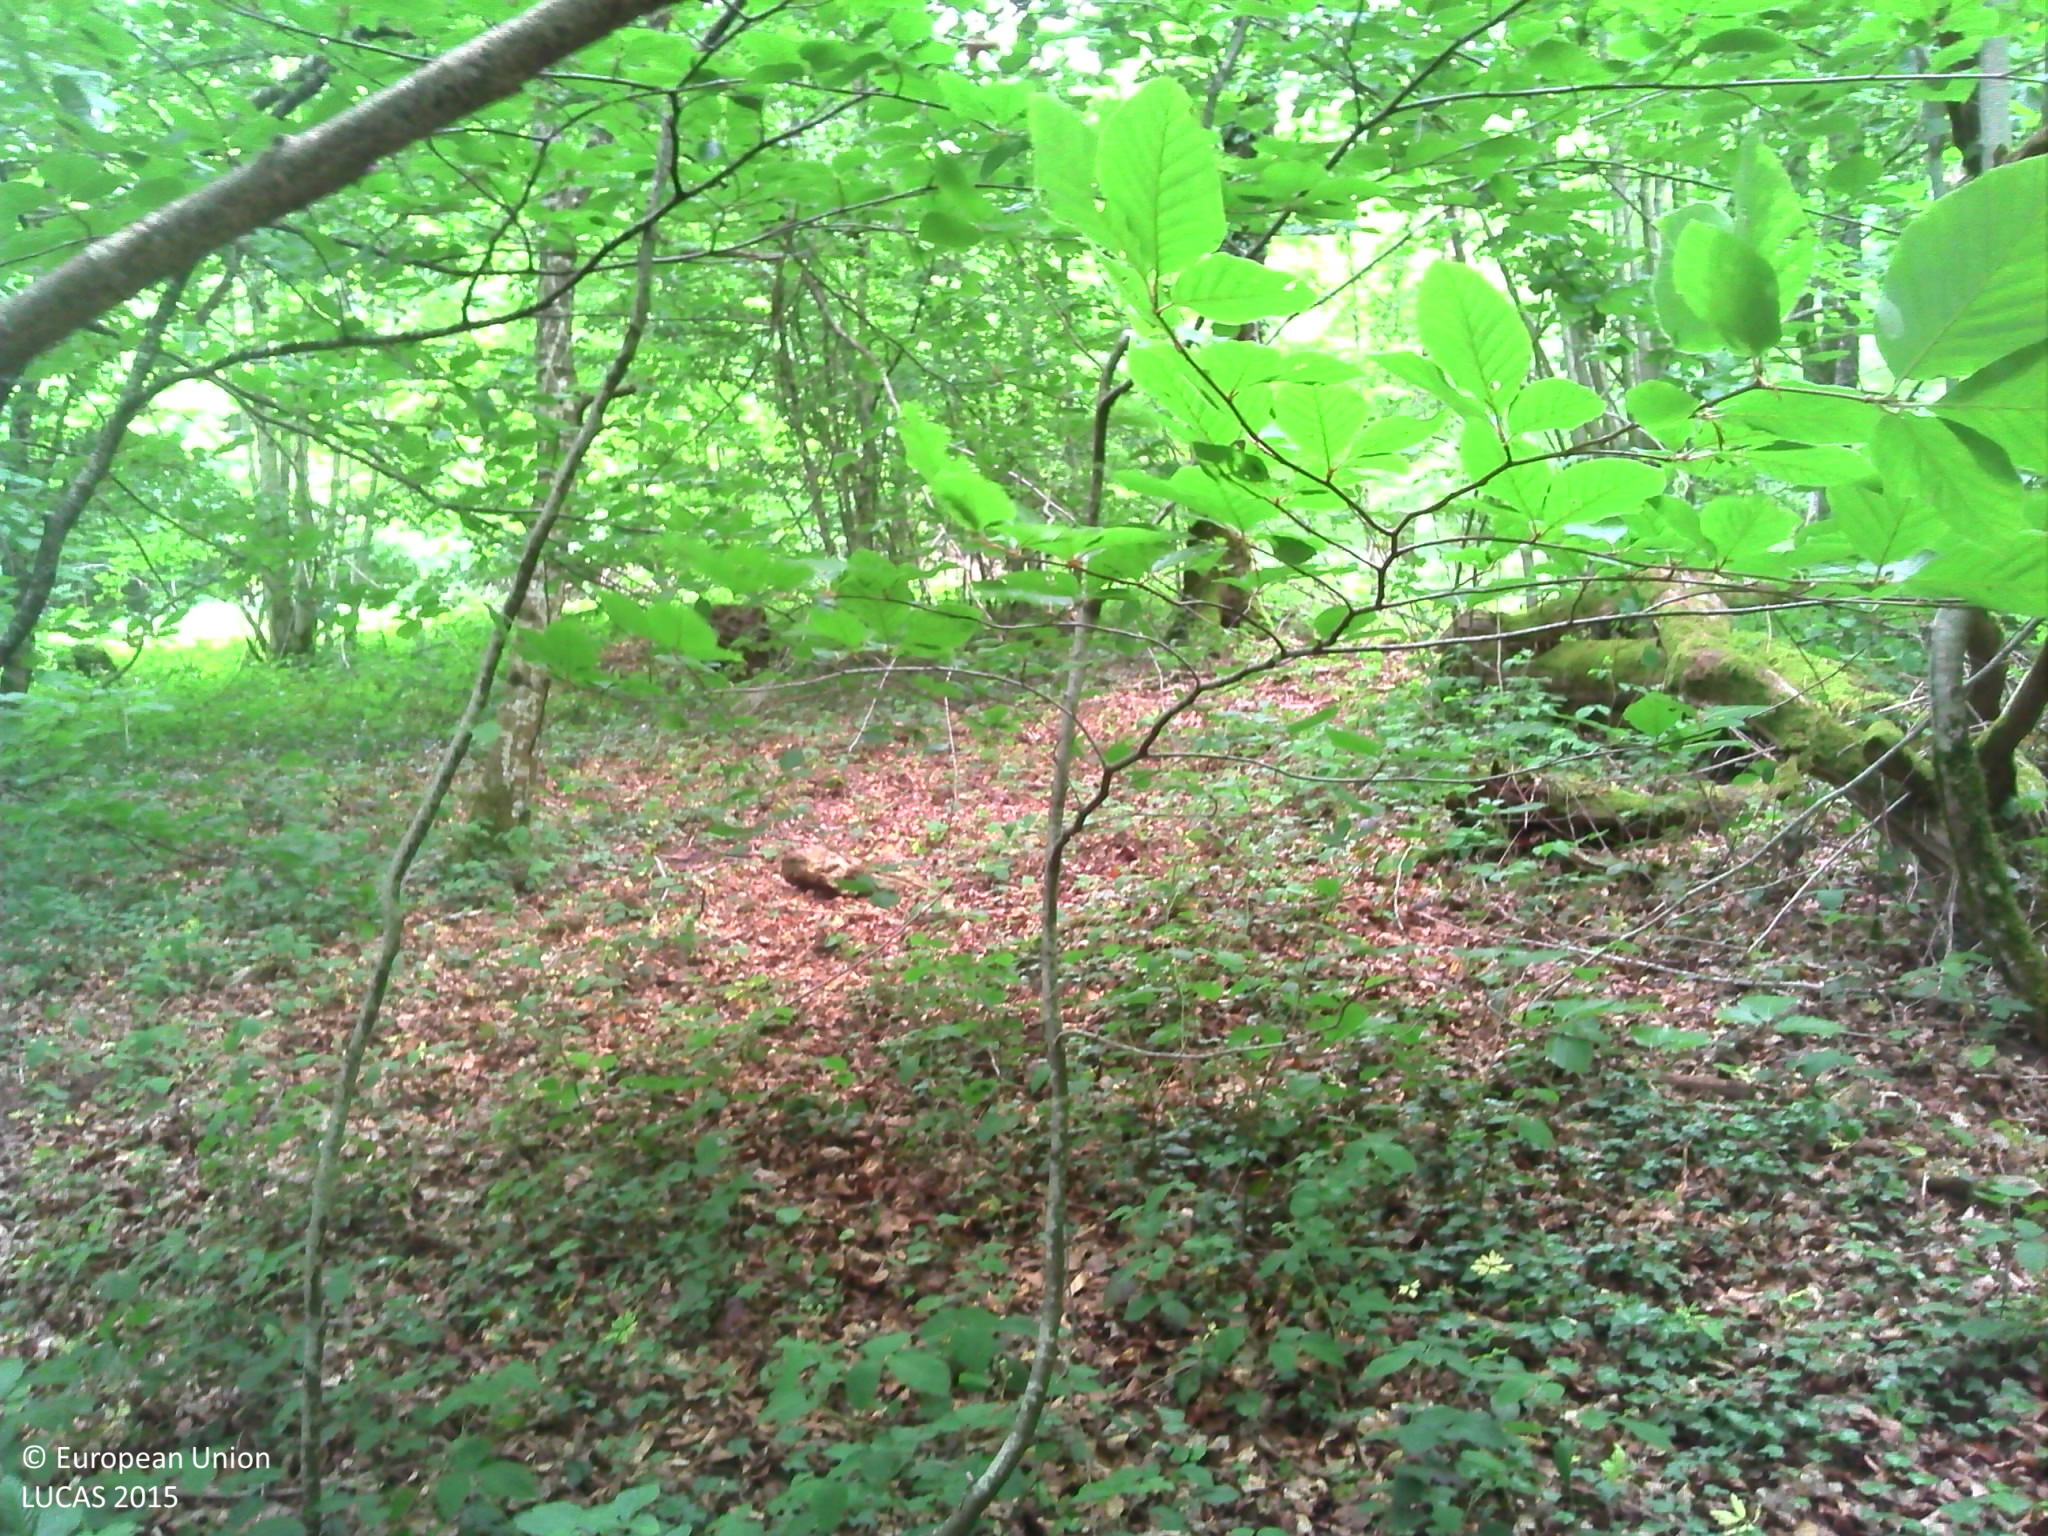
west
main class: Woodland
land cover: Broadleaved woodland
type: beech forest
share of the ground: > 75 %
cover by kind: broadleaved forest trees 90 %, herbaceous plants 10 %
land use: Forestry
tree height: > 5 m
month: June
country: FR
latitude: 48.3597
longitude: 4.9373
